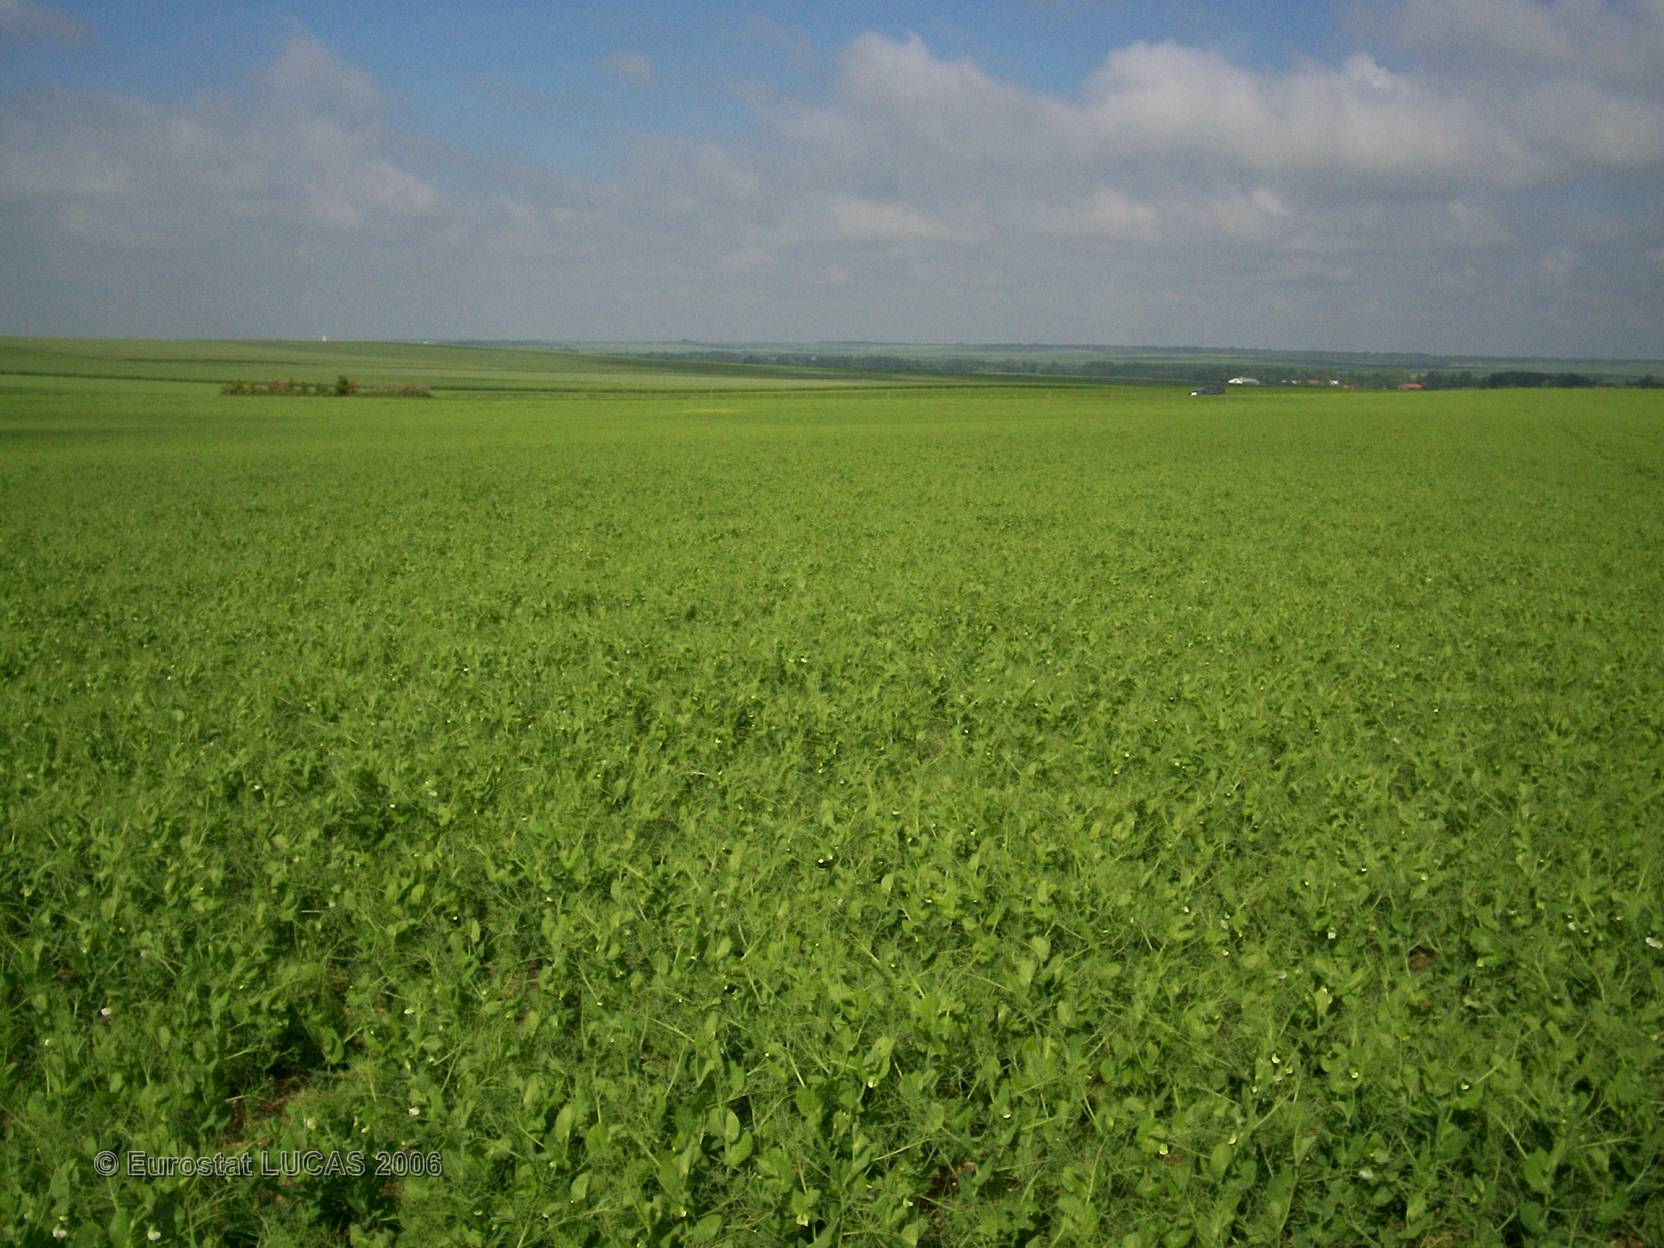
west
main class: Cropland
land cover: Dry pulses
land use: Agriculture (excluding fallow land and kitchen gardens)
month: June
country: FR
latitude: 48.5696
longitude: 4.4270
